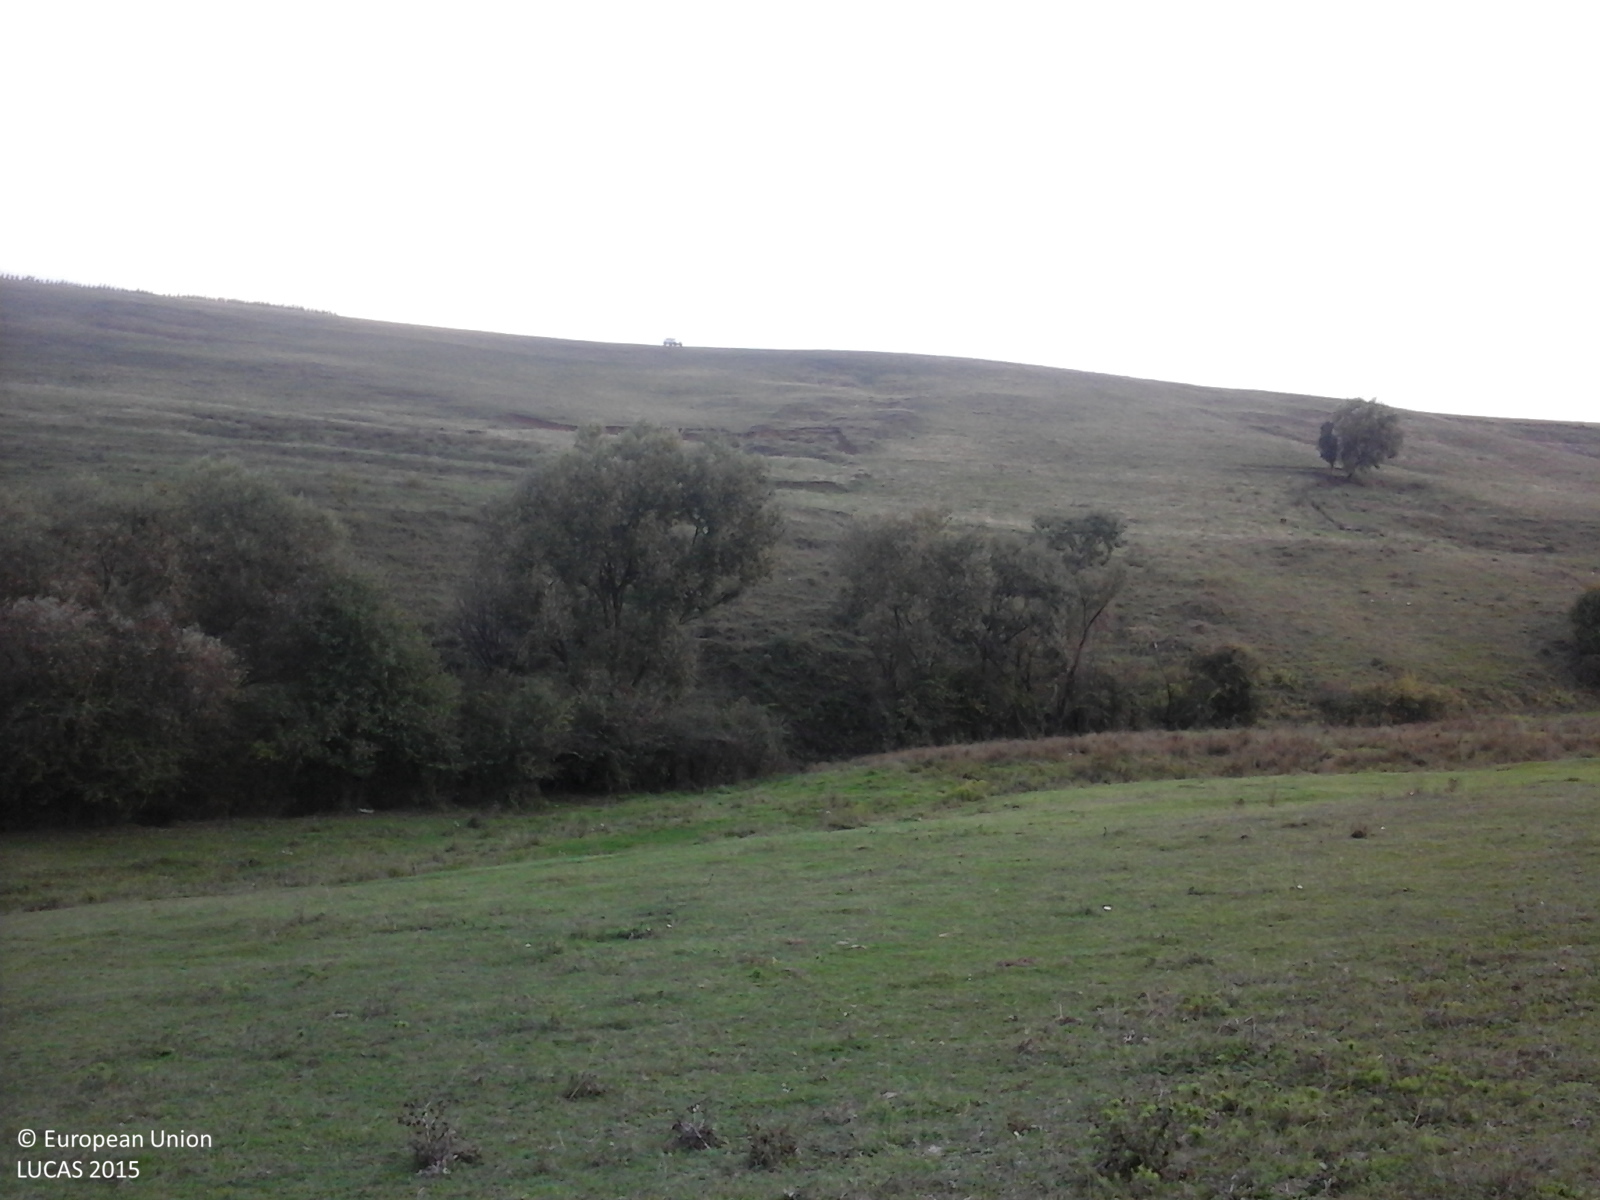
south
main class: Grassland
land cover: Grassland without tree/shrub cover
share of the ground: > 75 %
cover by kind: herbaceous plants 100 %
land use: Agriculture (excluding fallow land and kitchen gardens)
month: October
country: RO
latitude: 46.2241
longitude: 23.6163
